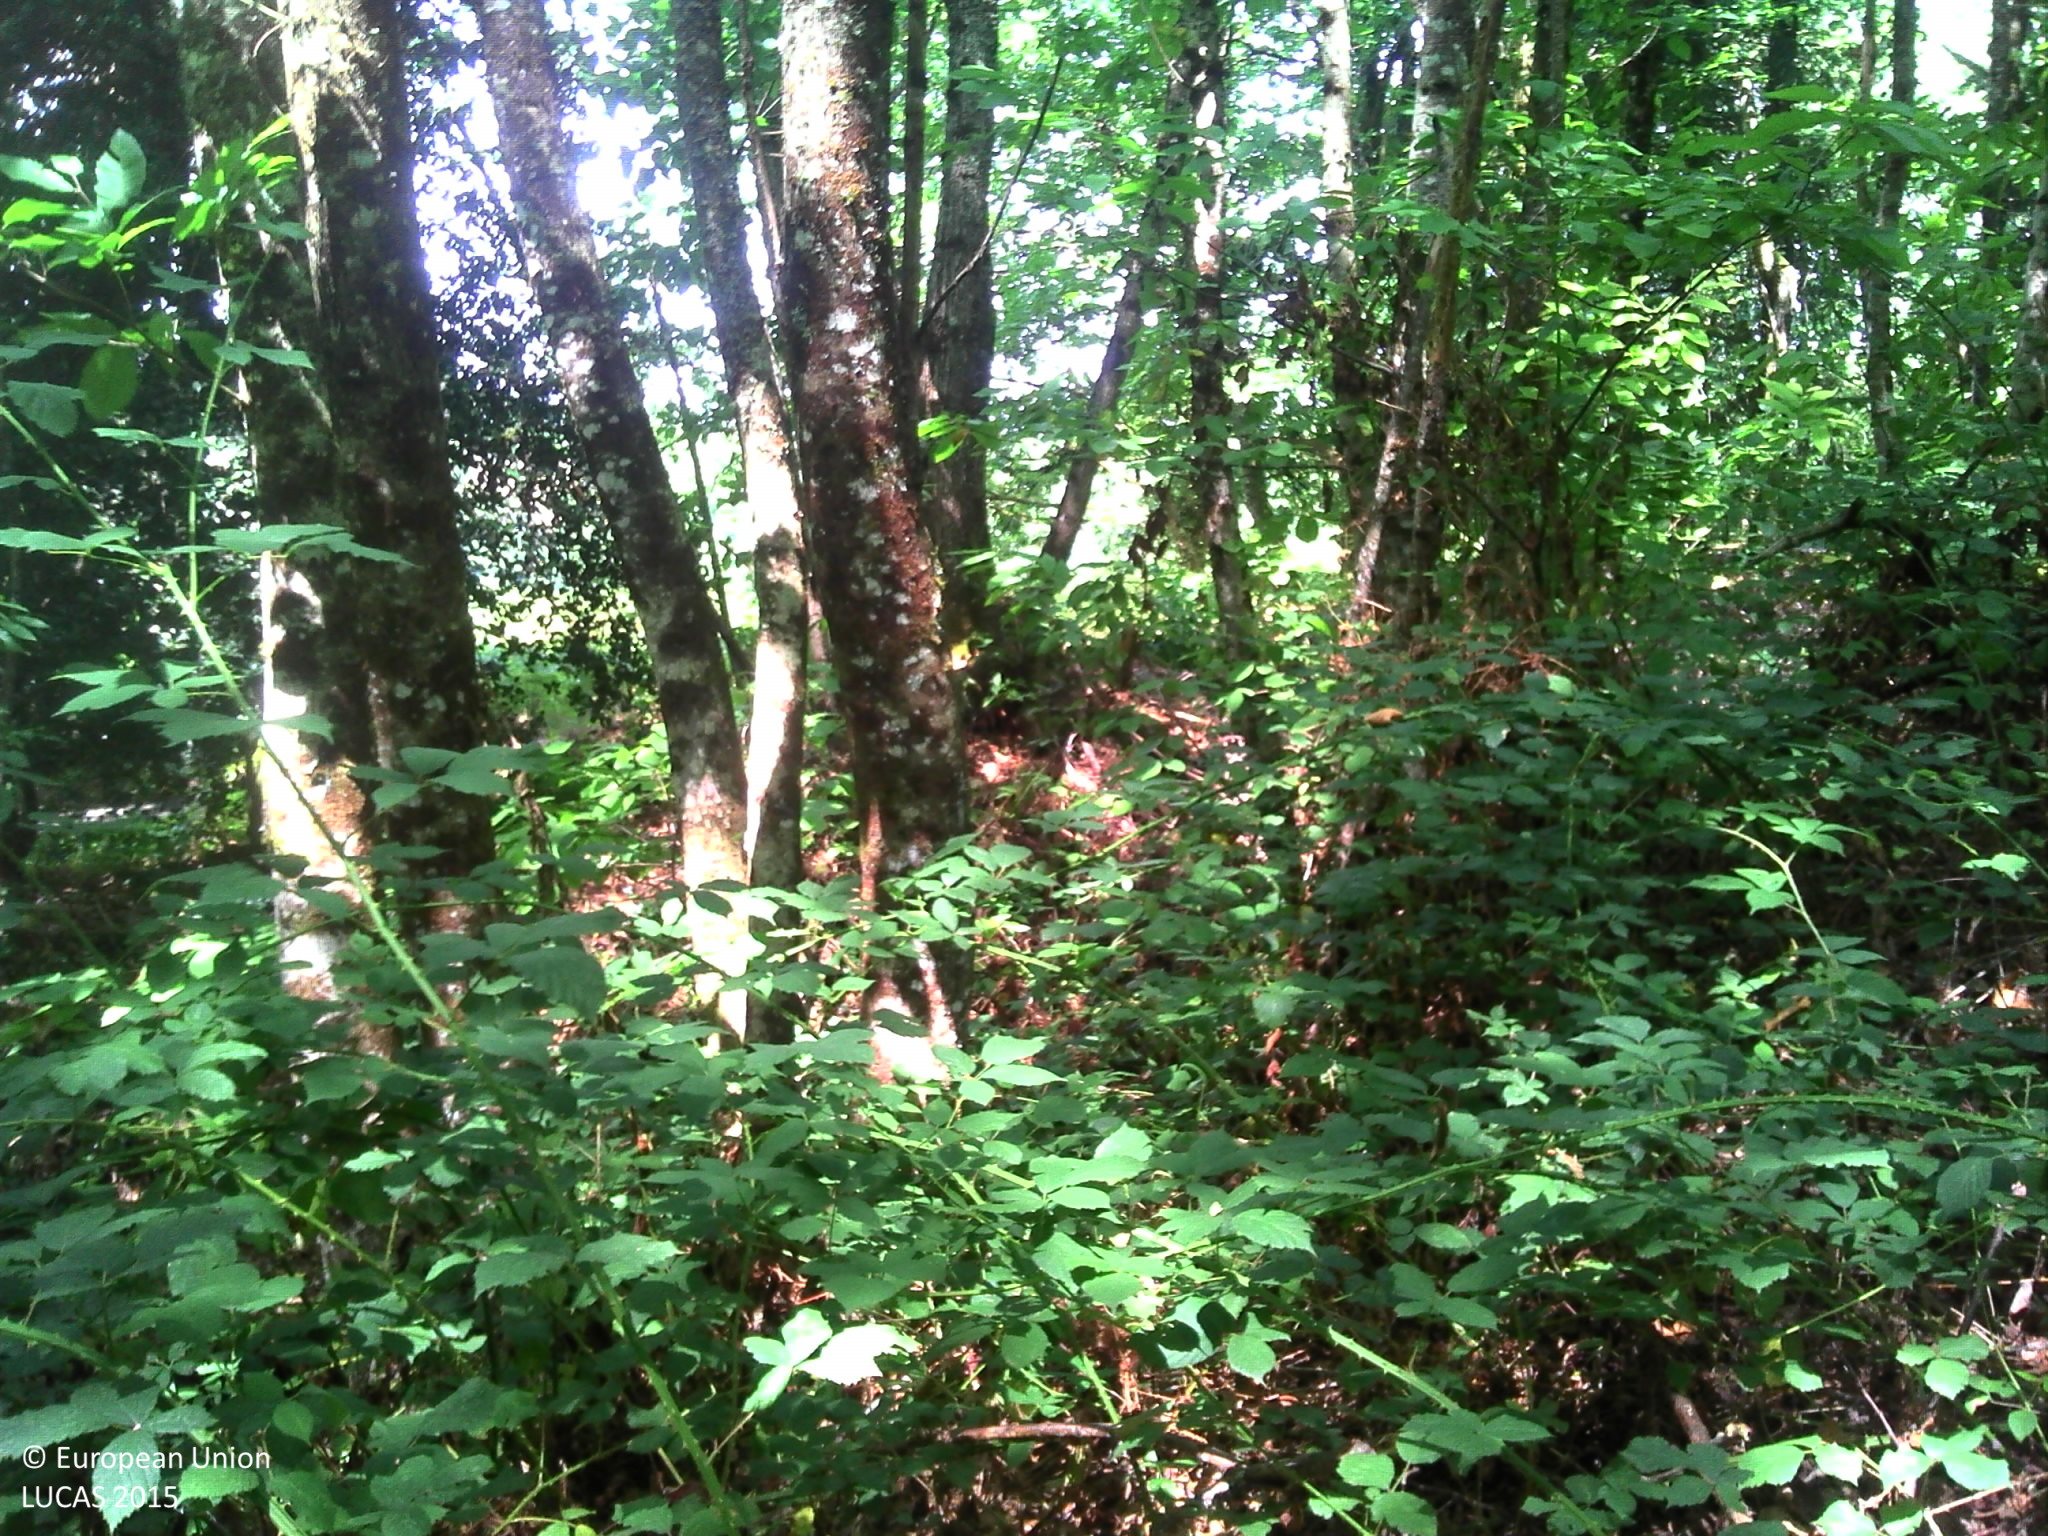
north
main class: Woodland
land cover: Broadleaved woodland
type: mesophytic deciduous forest
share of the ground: > 75 %
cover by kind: broadleaved forest trees 70 %, herbaceous plants 20 %, coniferous forest trees 10 %
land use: Abandoned areas
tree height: > 5 m
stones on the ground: < 10 %
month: August
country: FR
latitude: 46.0614
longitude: 1.2123
